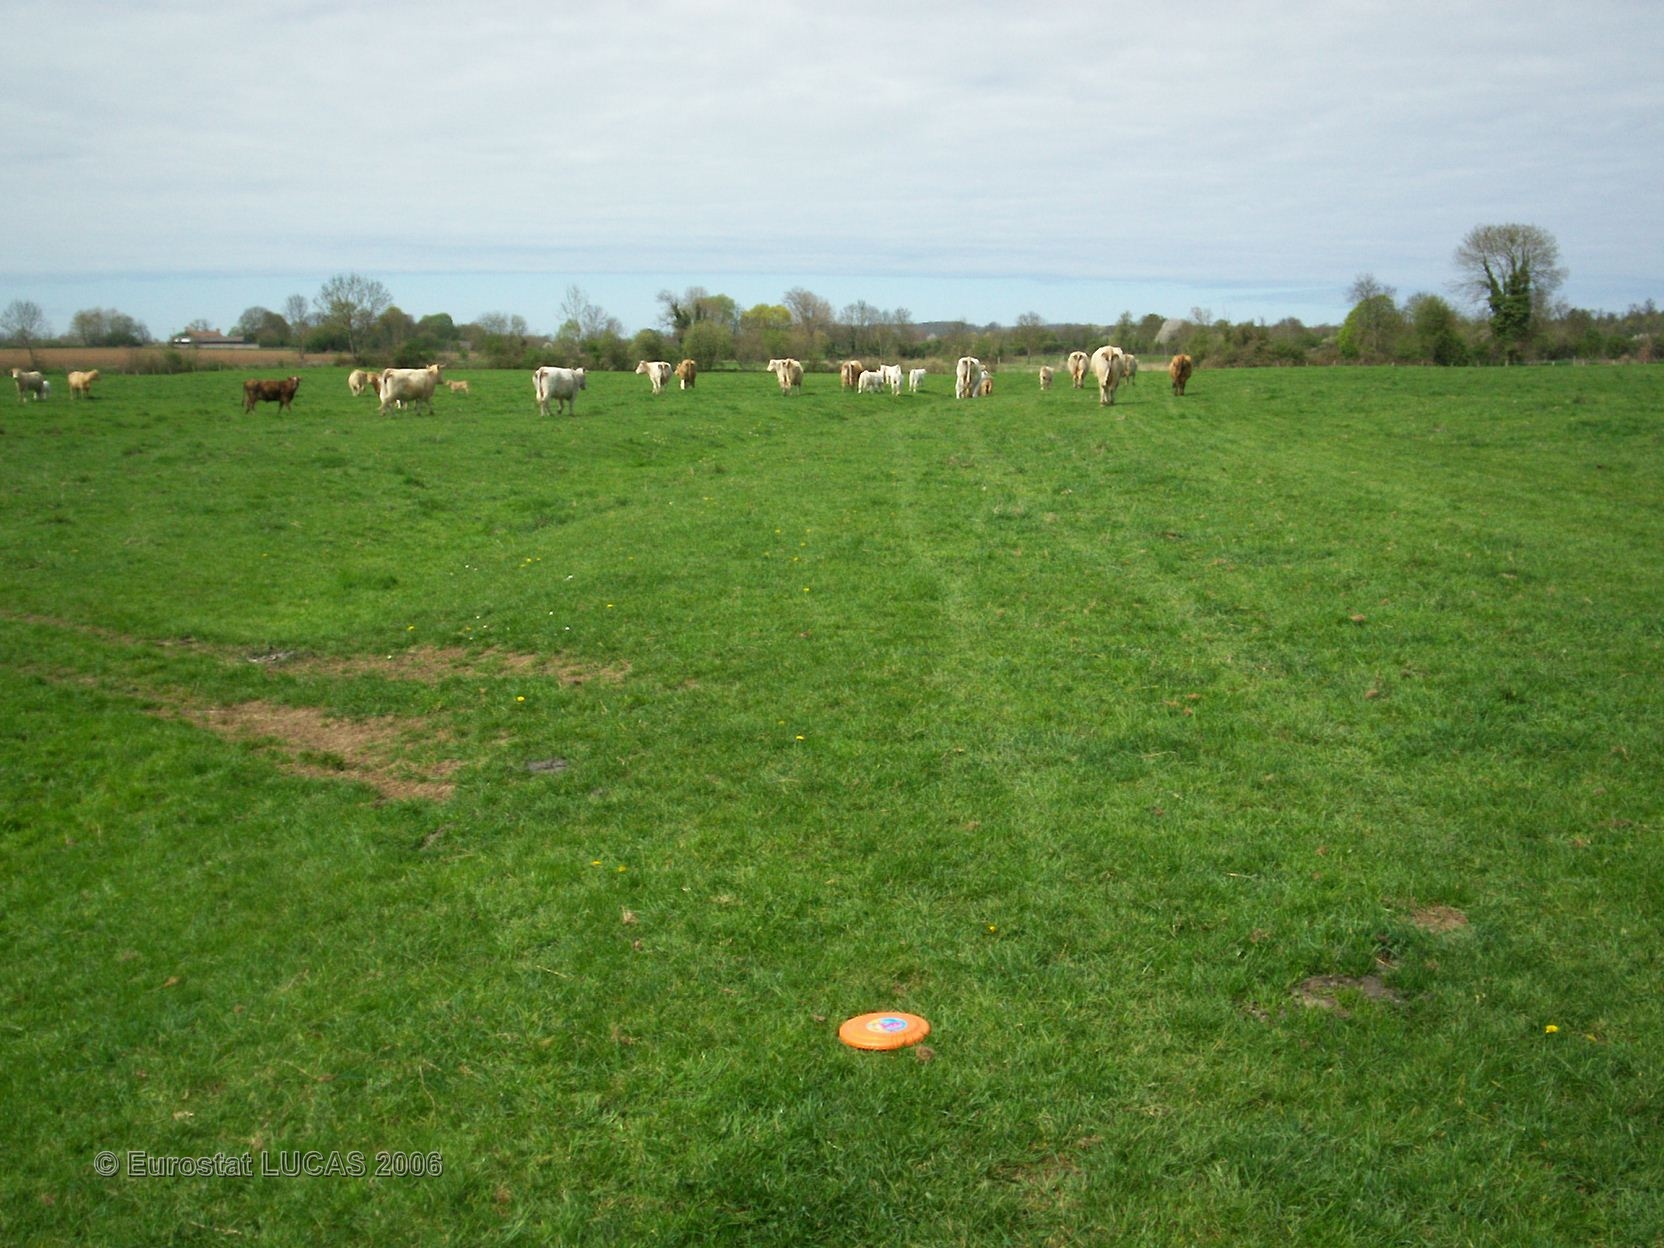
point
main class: Grassland
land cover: Grassland without tree/shrub cover
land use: Agriculture (excluding fallow land and kitchen gardens)
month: April
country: FR
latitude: 49.1640
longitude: -0.1952
